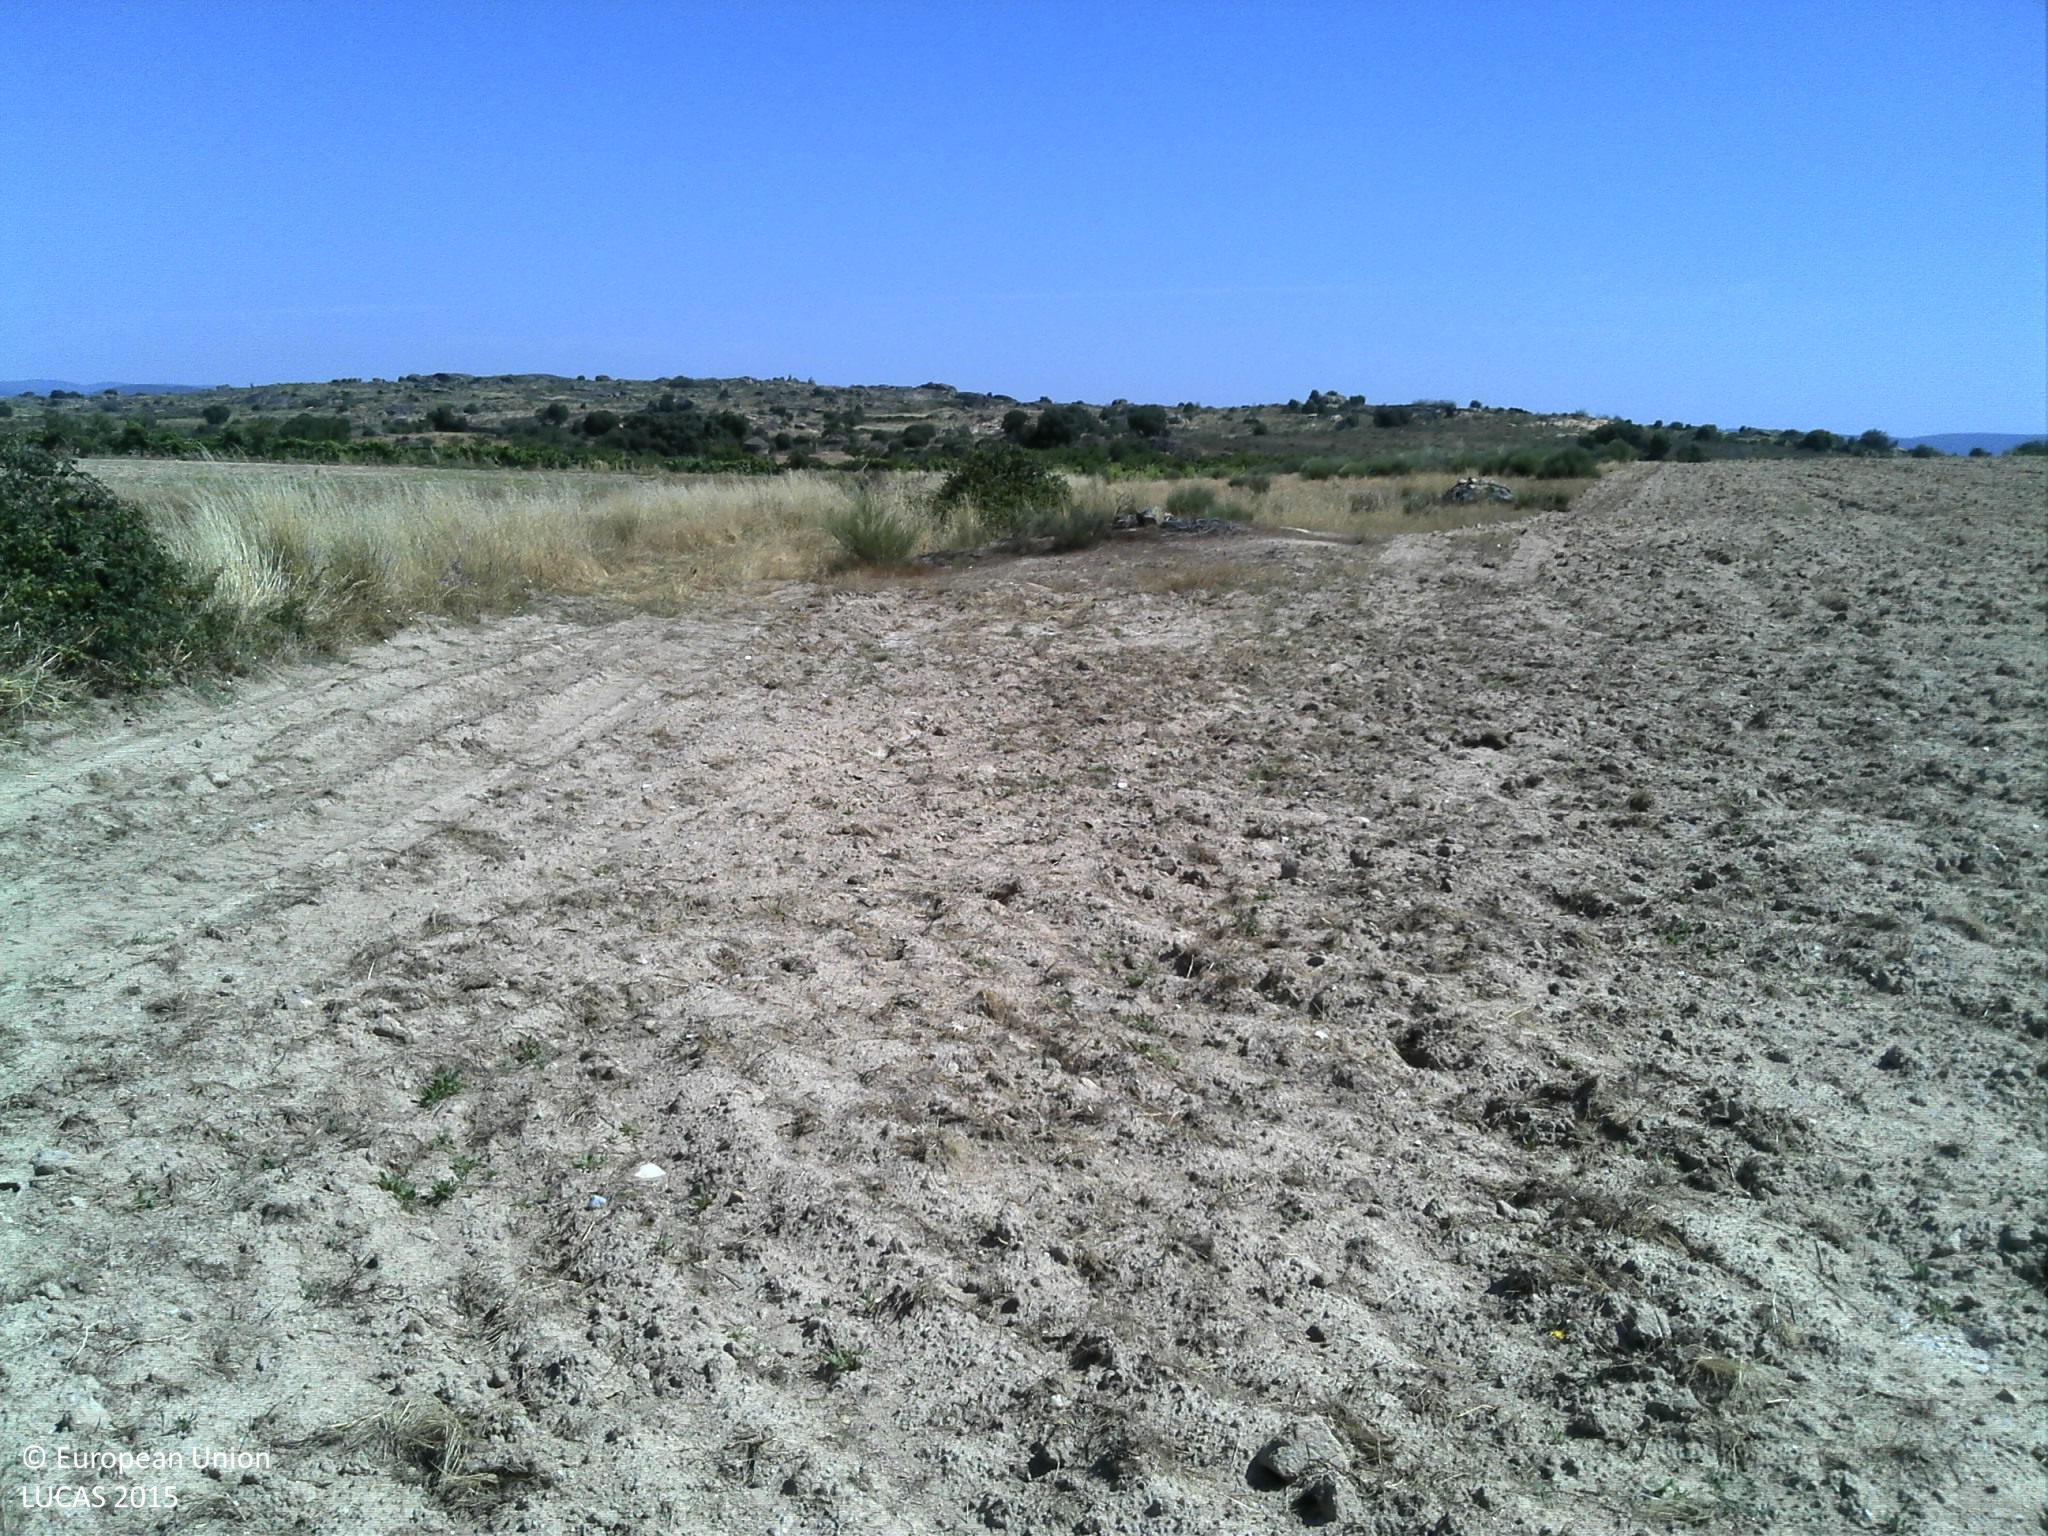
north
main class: Cropland
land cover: Durum wheat
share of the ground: < 10 %
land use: Agriculture (excluding fallow land and kitchen gardens)
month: June
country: PT
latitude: 40.9611
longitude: -6.9166
